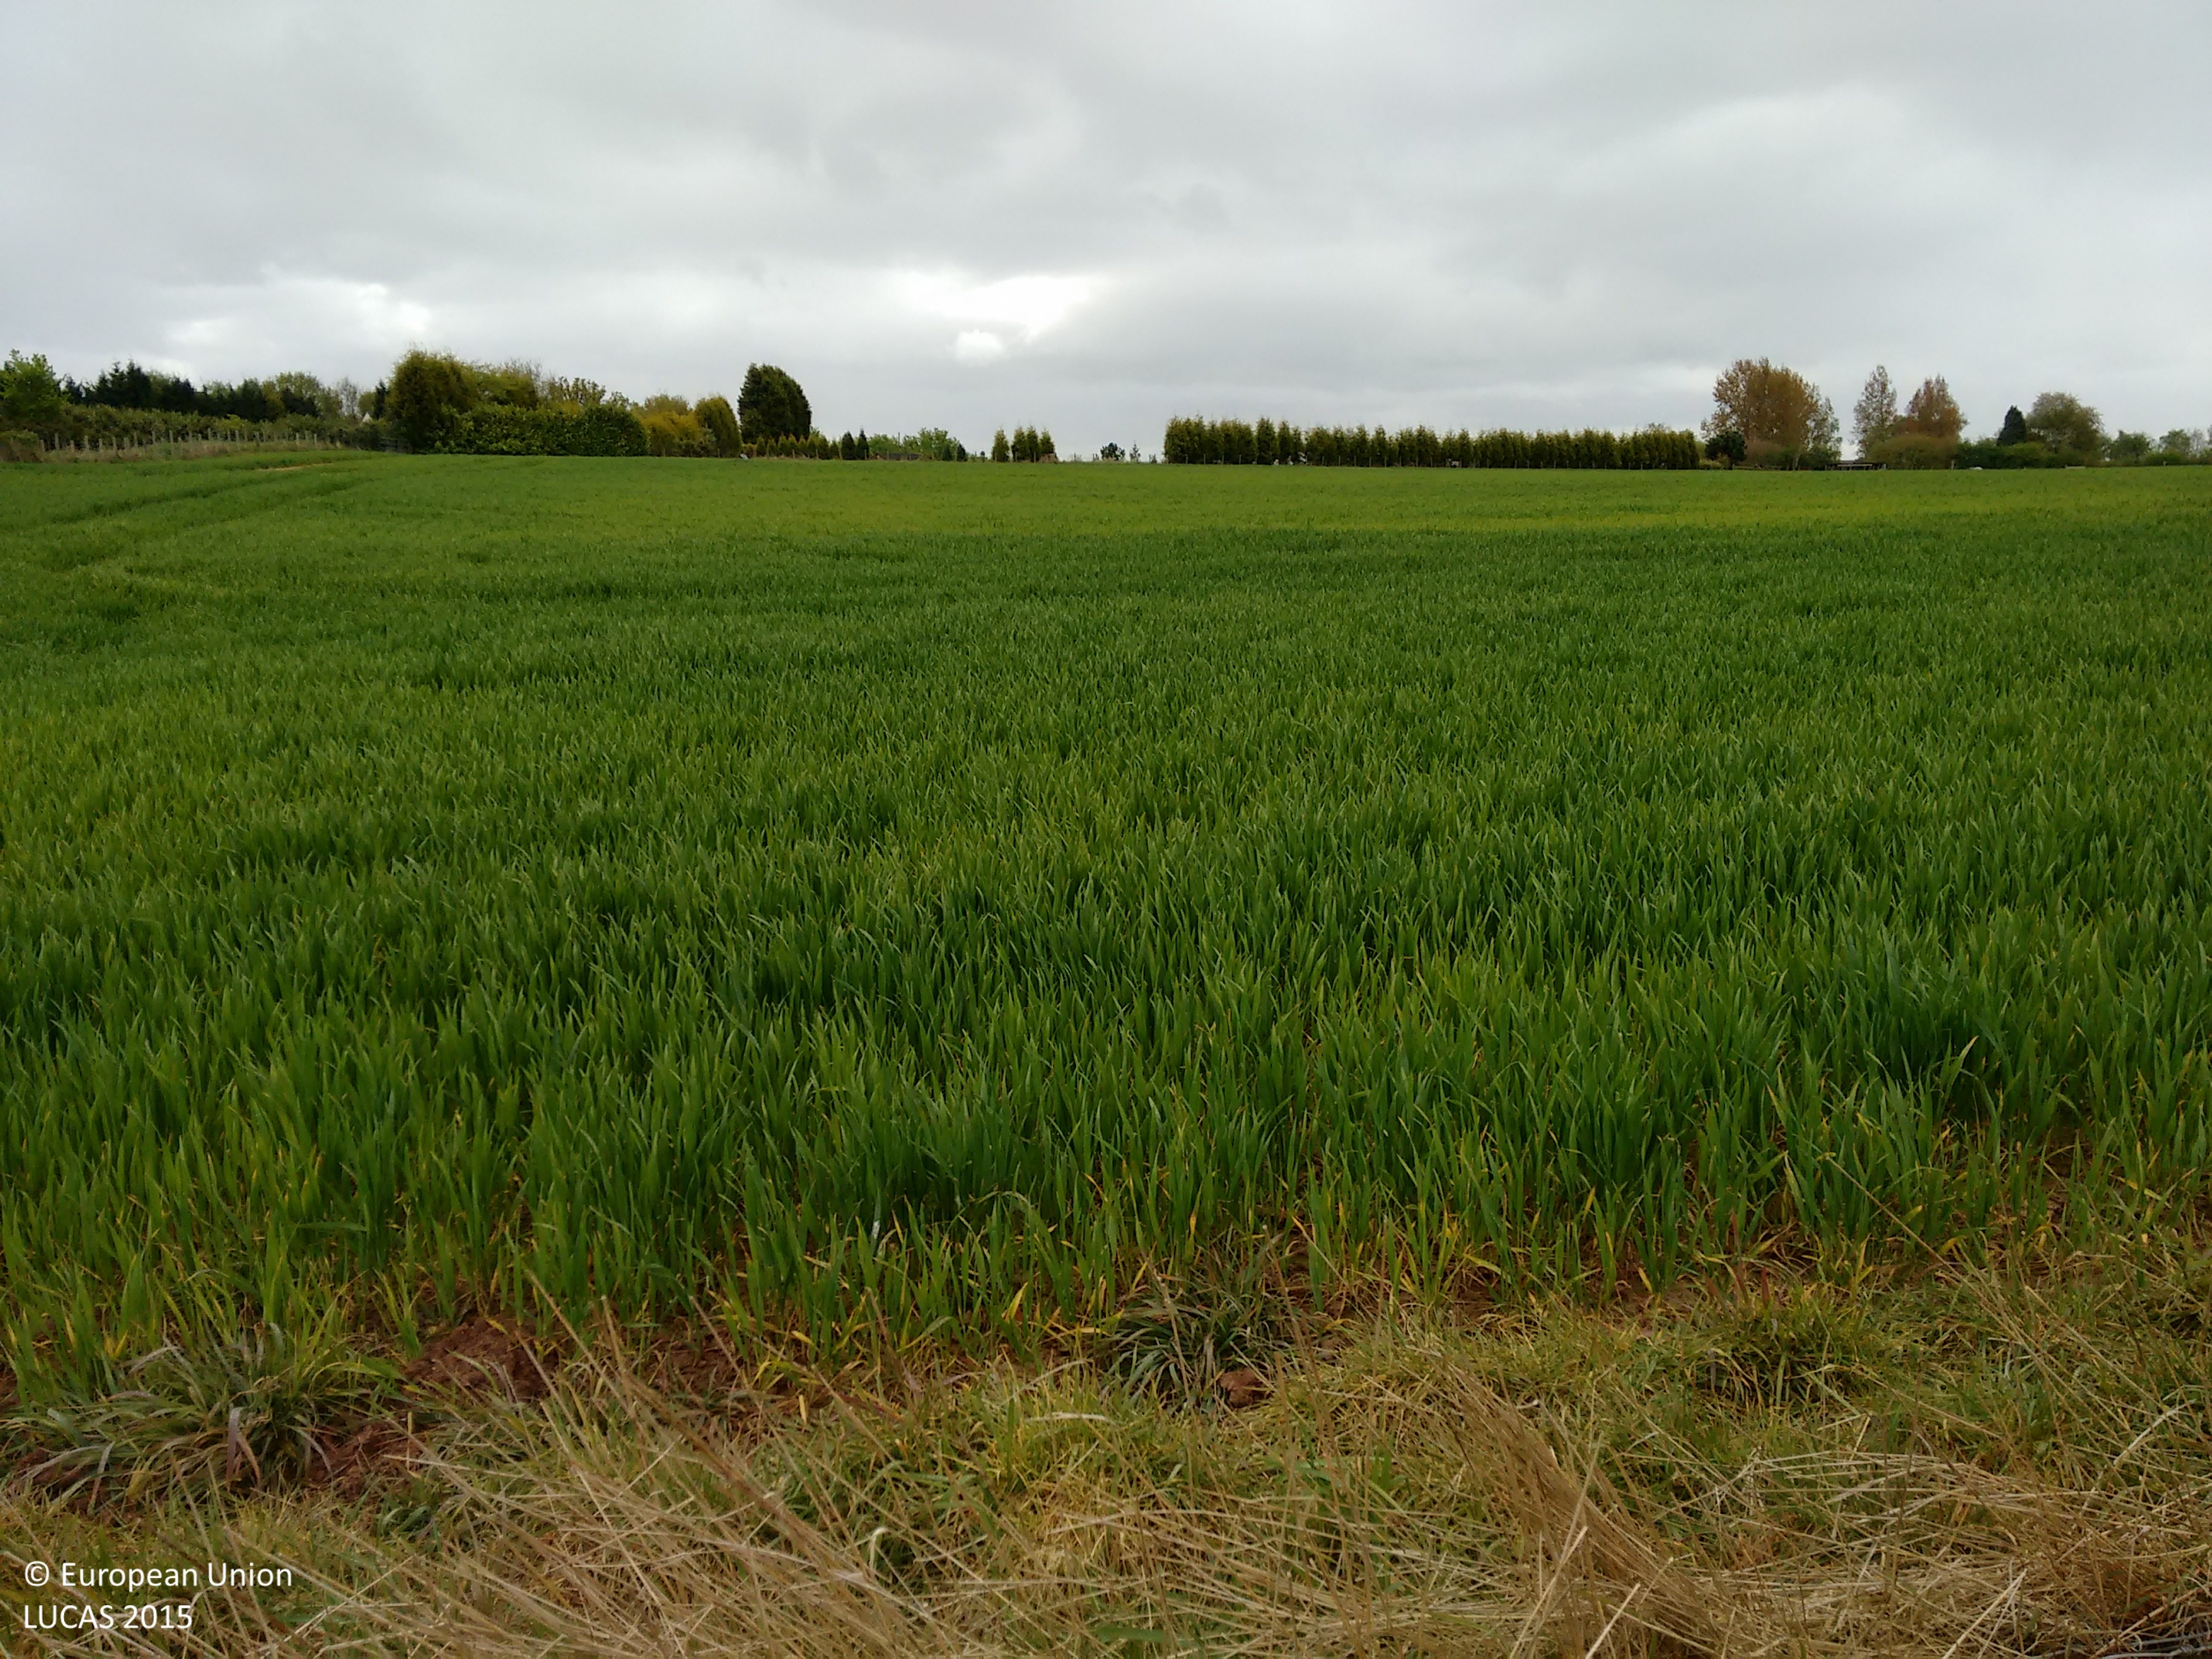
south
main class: Cropland
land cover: Common wheat
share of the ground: 25 - 50 %
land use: Agriculture (excluding fallow land and kitchen gardens)
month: April
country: GB
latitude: 52.3632
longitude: -2.2062
